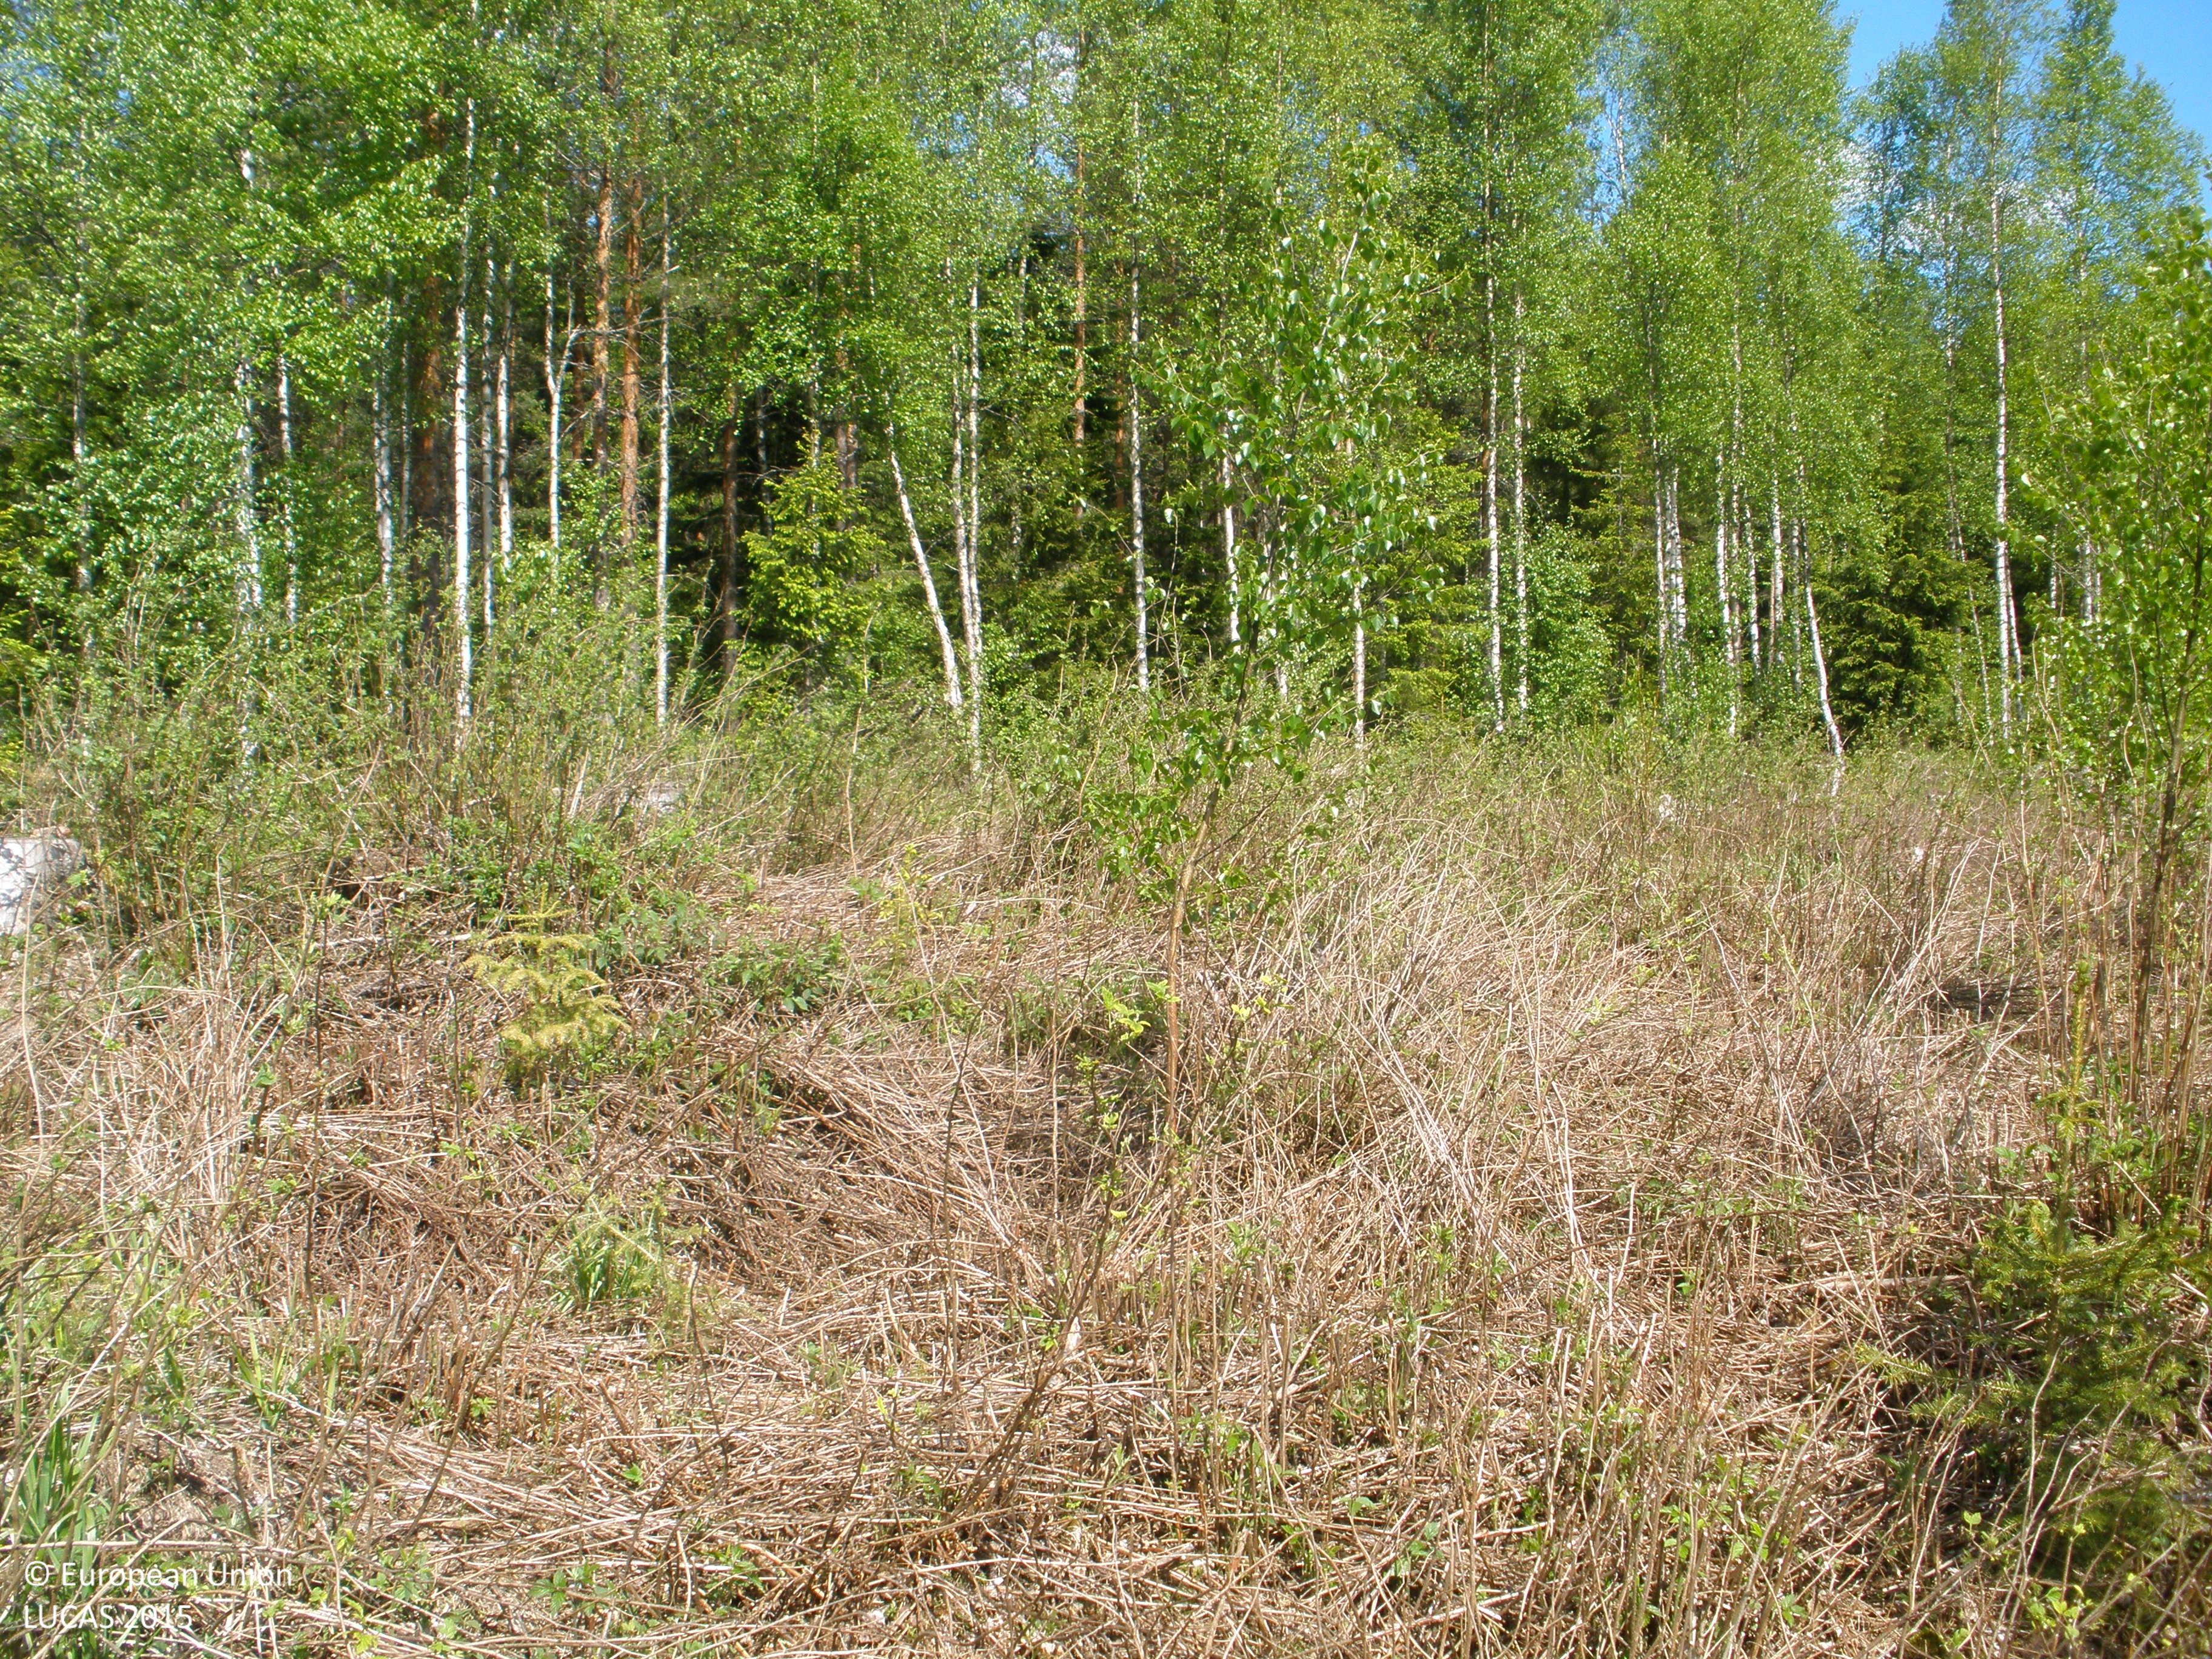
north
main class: Woodland
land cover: Broadleaved woodland
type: boreal forest
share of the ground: 25 - 50 %
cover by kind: shrubs 50 %, broadleaved forest trees 30 %, herbaceous plants 15 %, coniferous forest trees 5 %
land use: Forestry
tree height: < 5 m
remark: Nursery
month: June
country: FI
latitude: 60.6635
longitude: 24.0572
